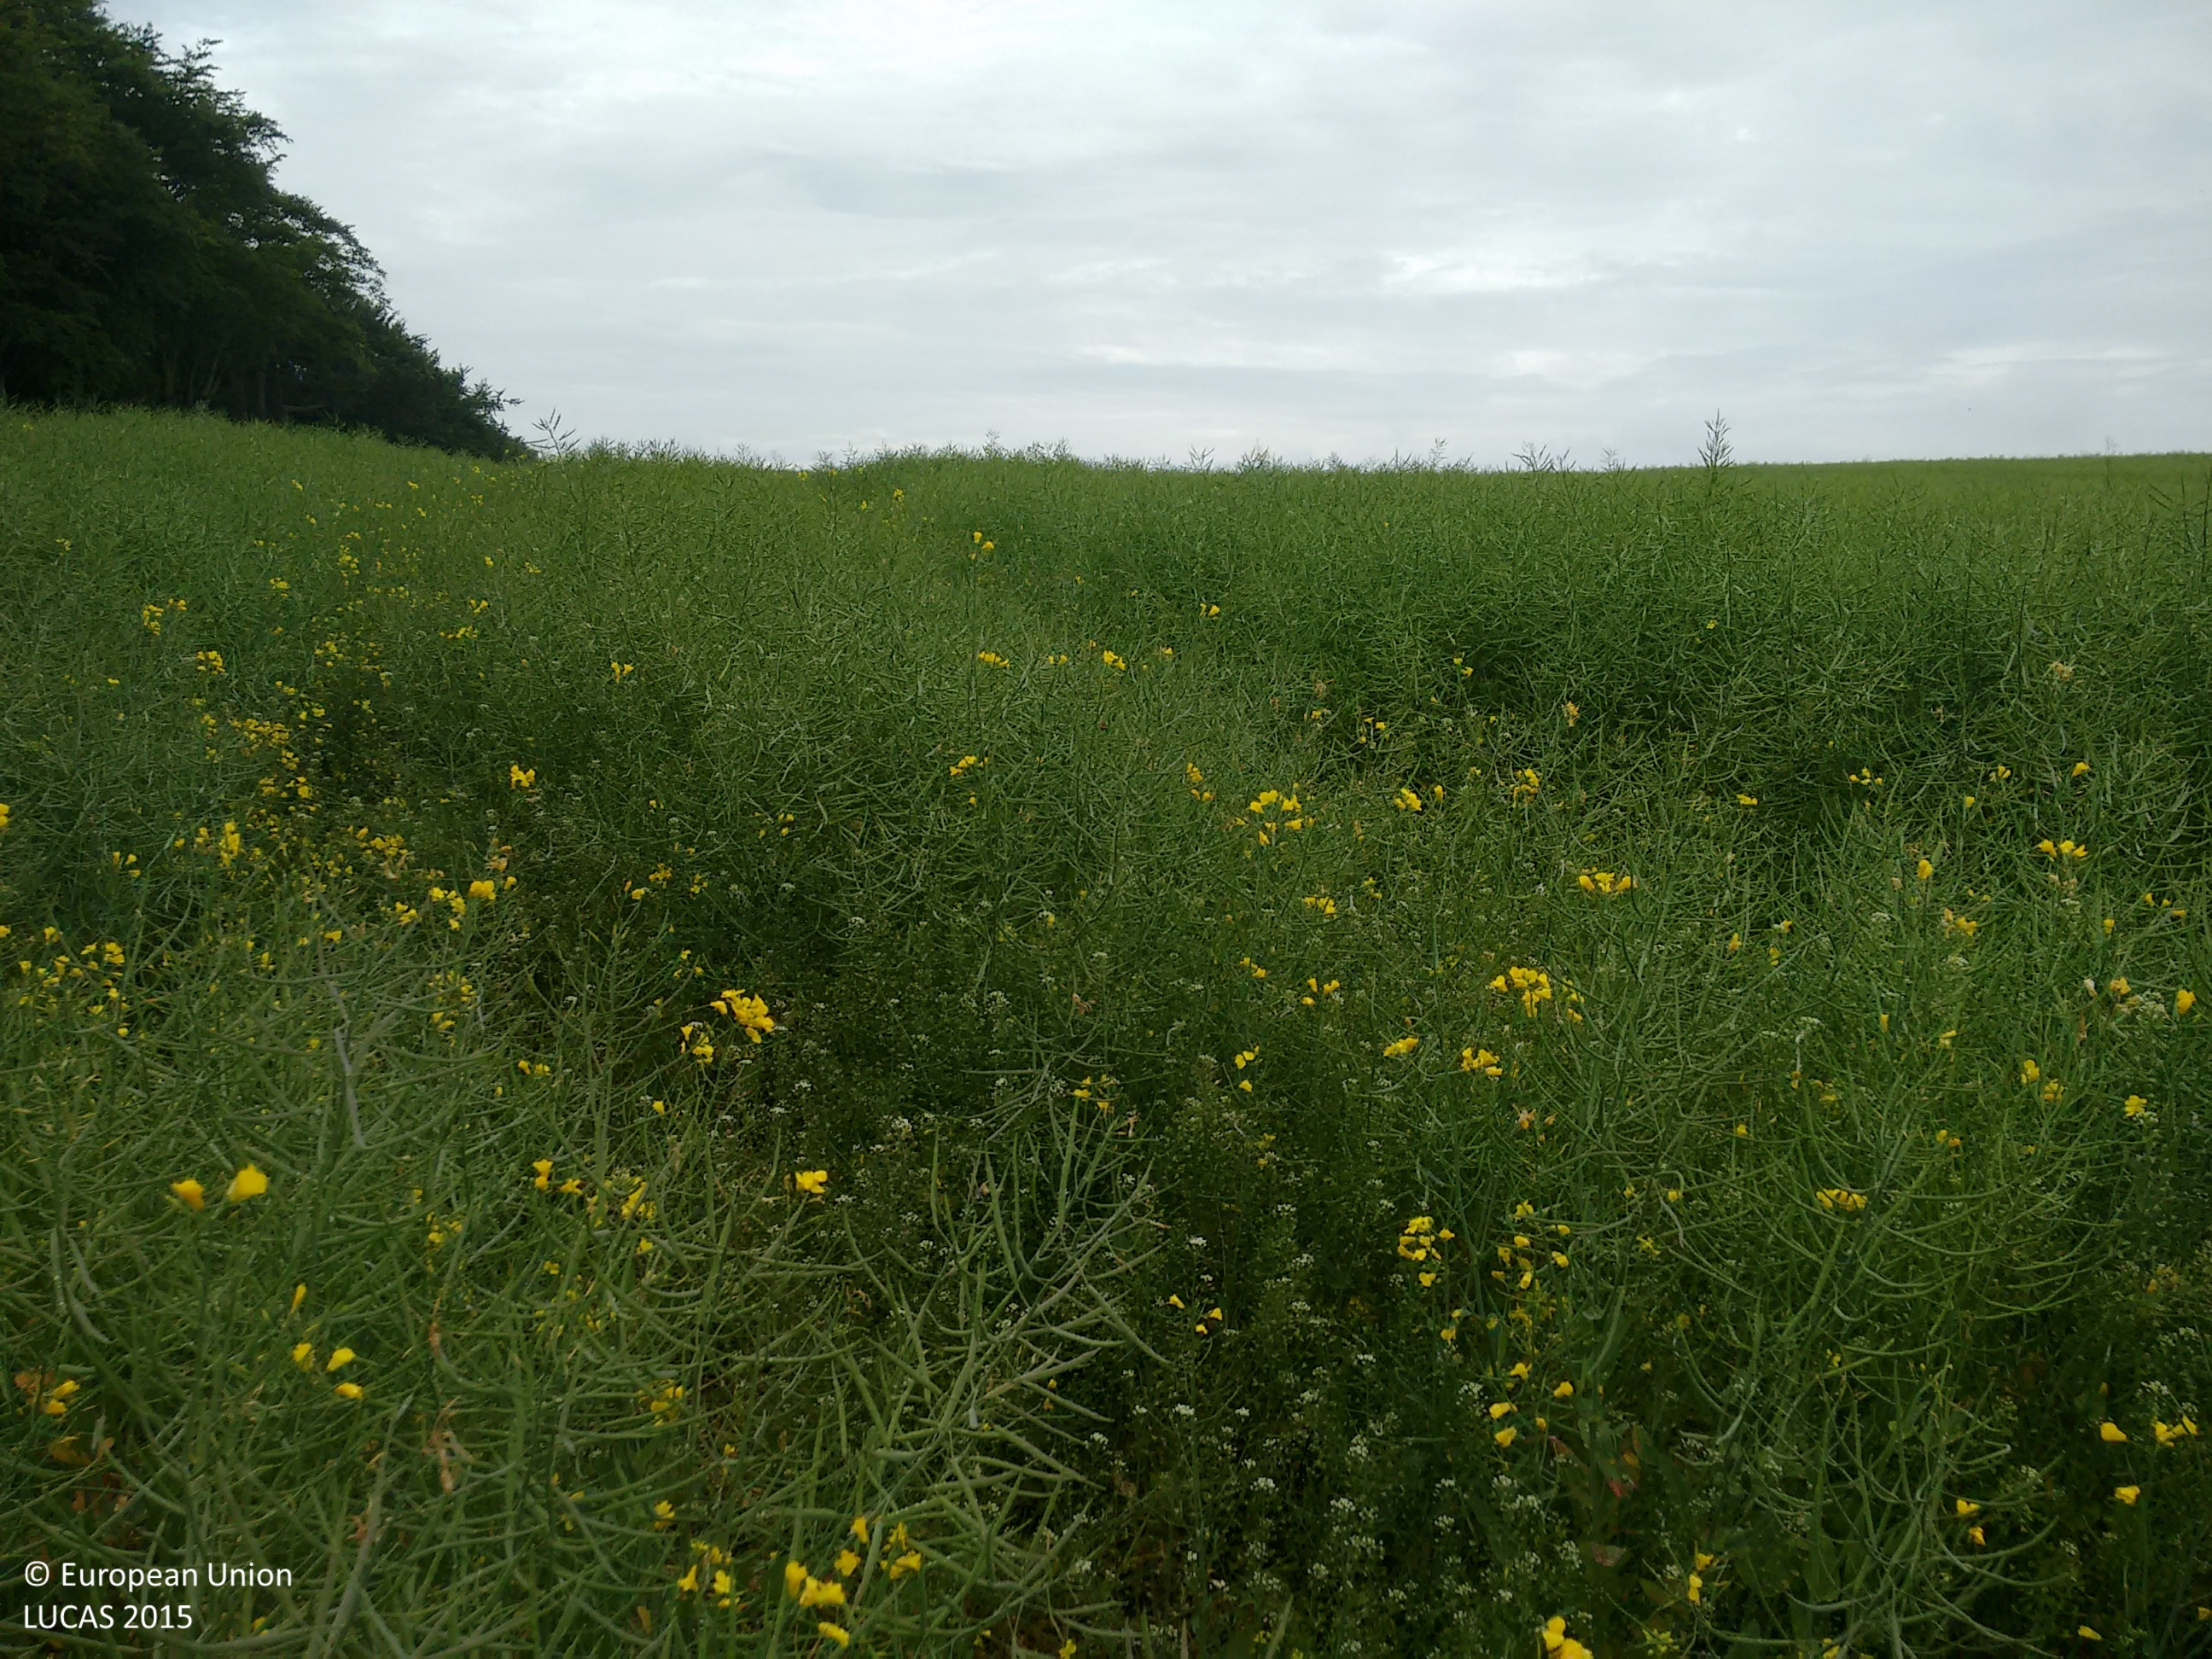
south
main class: Cropland
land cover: Rape and turnip rape
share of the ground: > 75 %
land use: Agriculture (excluding fallow land and kitchen gardens)
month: June
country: GB
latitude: 54.7031
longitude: -1.3276
